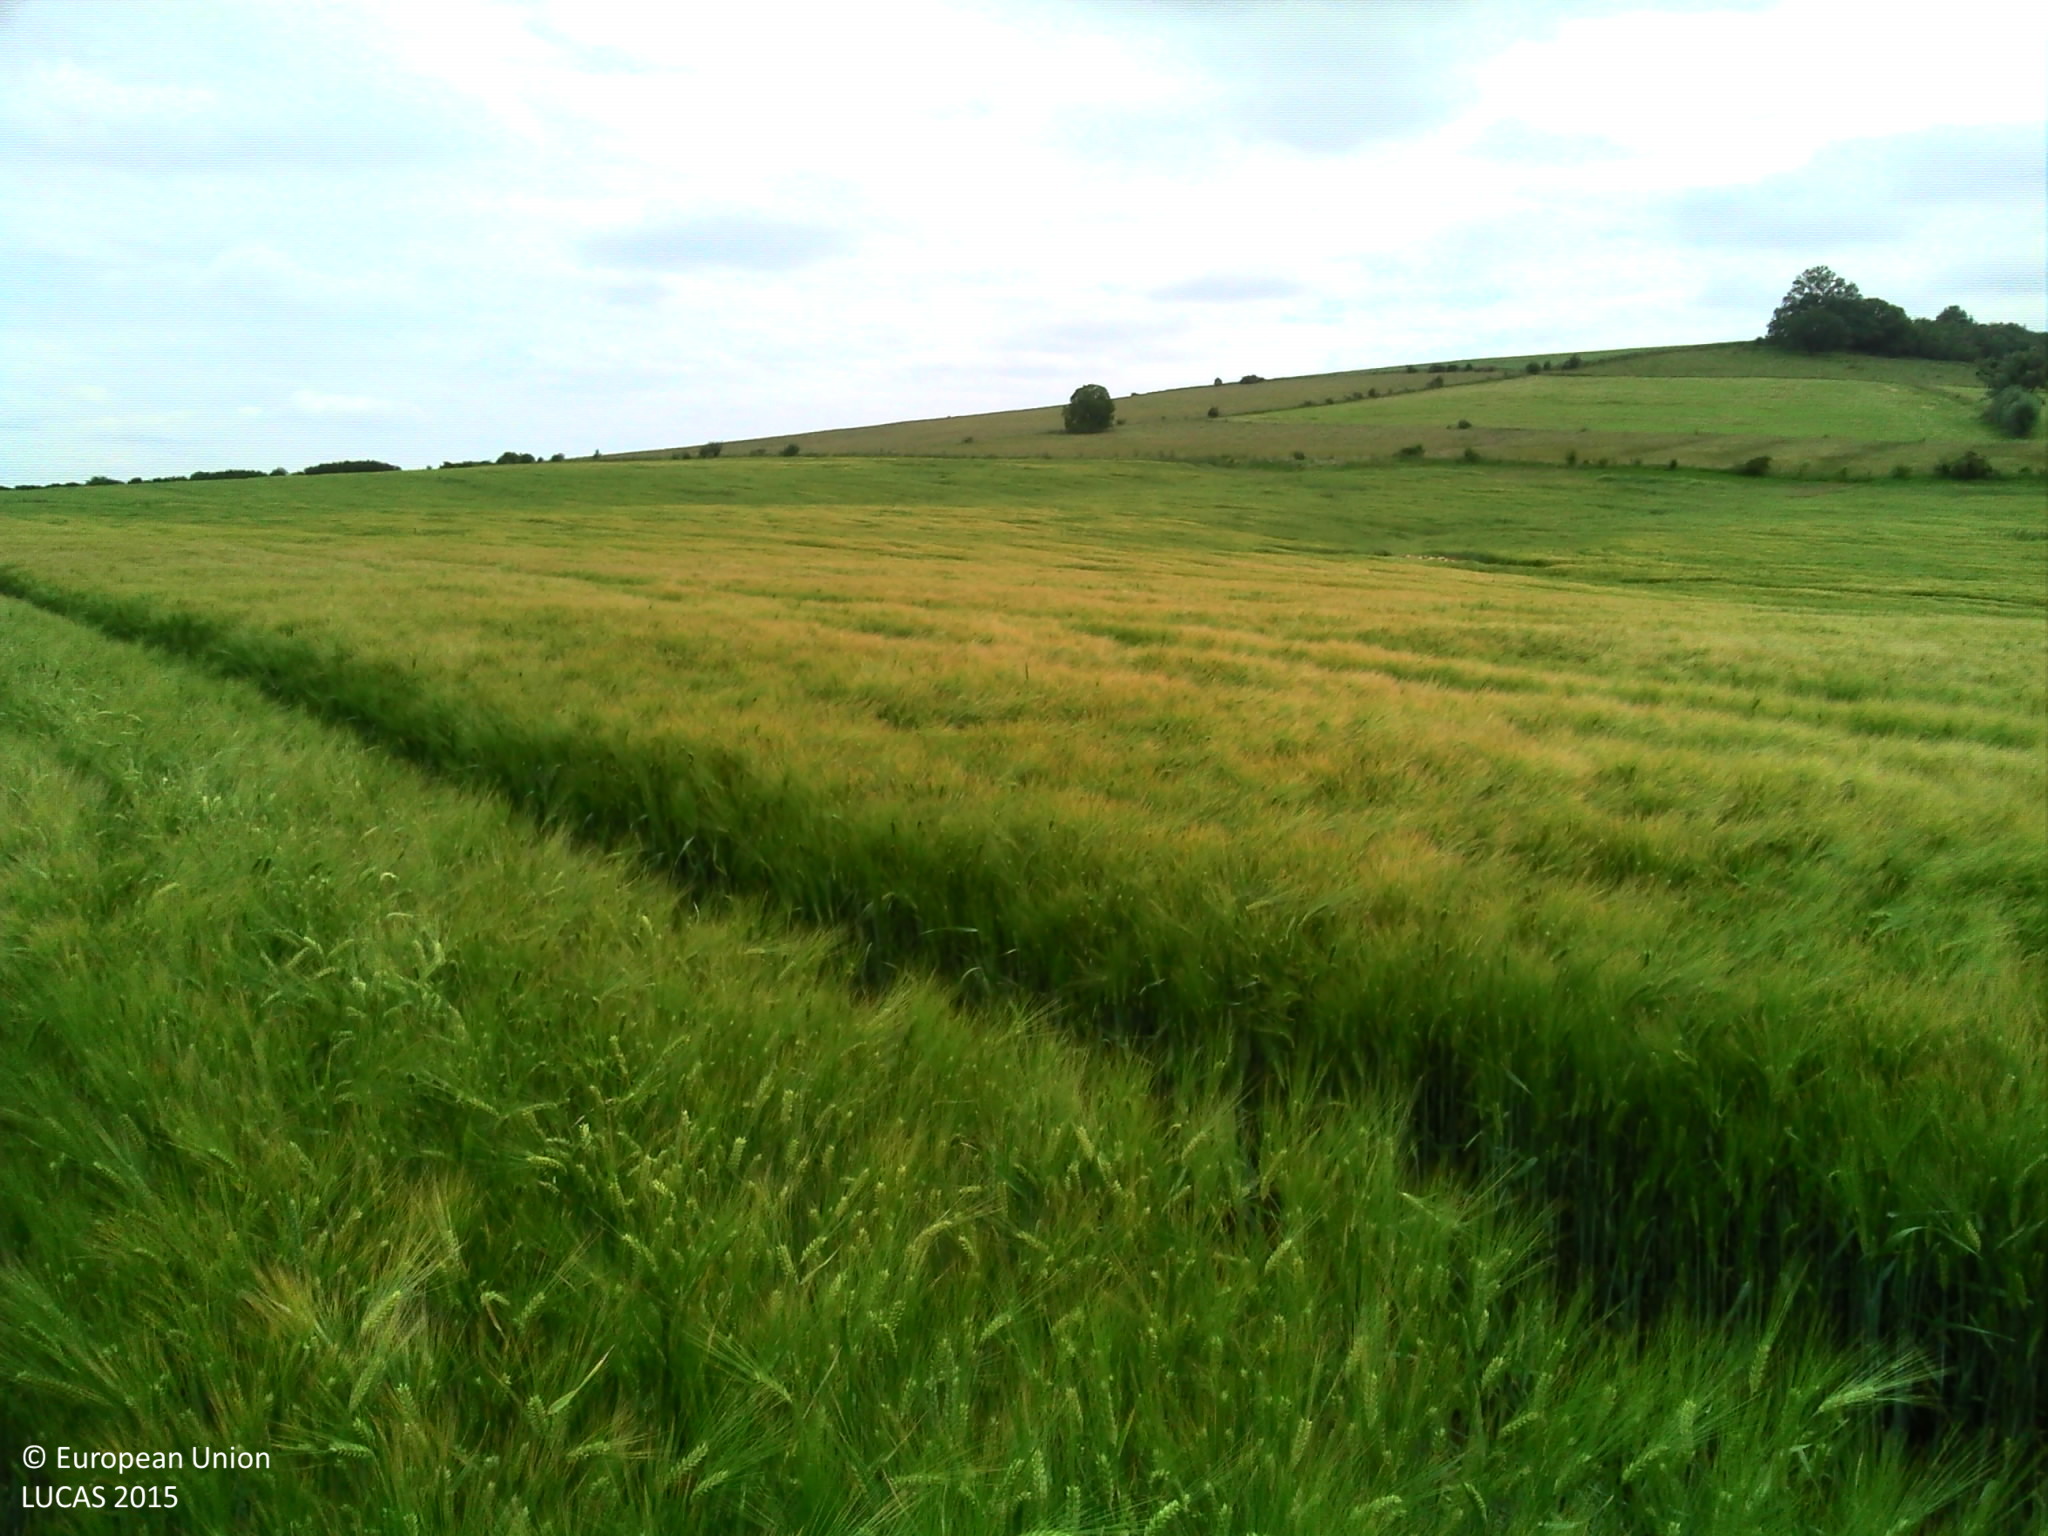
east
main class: Cropland
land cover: Barley
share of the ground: > 75 %
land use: Agriculture (excluding fallow land and kitchen gardens)
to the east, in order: Barley; Spontaneously vegetated surfaces
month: June
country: FR
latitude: 48.8415
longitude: 6.1711
